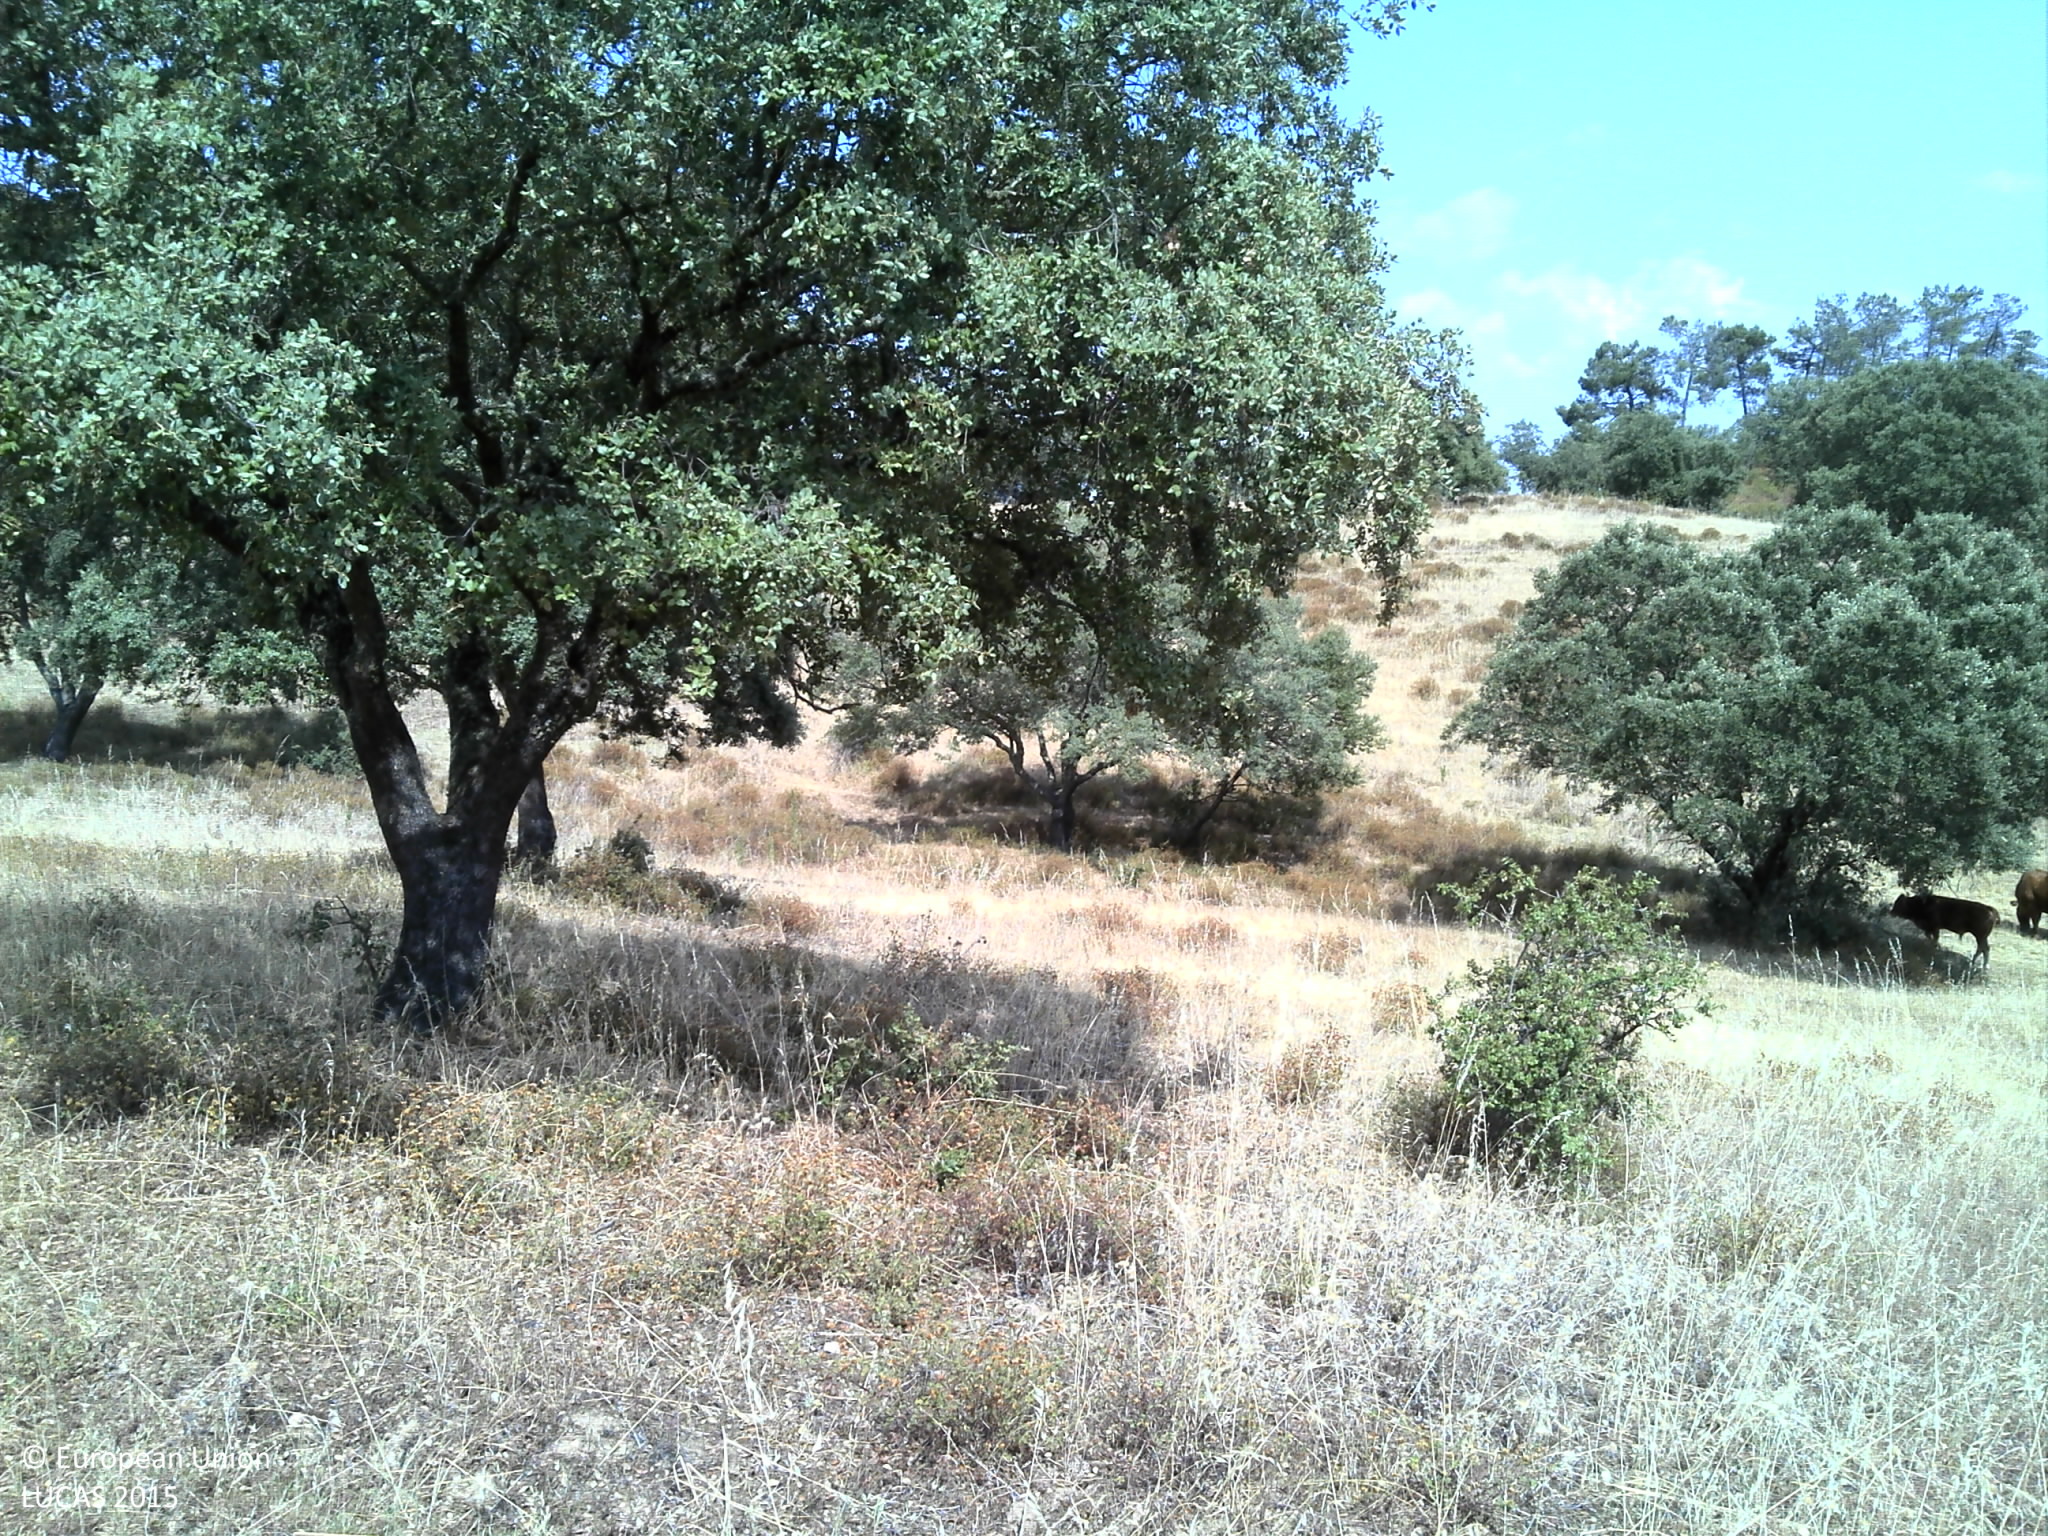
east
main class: Grassland
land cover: Grassland with sparse tree/shrub cover
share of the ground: > 75 %
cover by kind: herbaceous plants 80 %, unconsolidated bare surface 15 %, broadleaved forest trees 5 %
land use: Agriculture (excluding fallow land and kitchen gardens)
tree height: > 5 m
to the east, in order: Grassland with sparse tree/shrub cover; Broadleaved woodland; Rivers and streams; Grassland without tree/shrub cover; Tracks; Broadleaved woodland; Grassland with sparse tree/shrub cover; Broadleaved woodland; Dry stone walls; Tracks; Rock outcrops; Broadleaved woodland
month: June
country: PT
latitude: 38.6620
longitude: -7.6997
